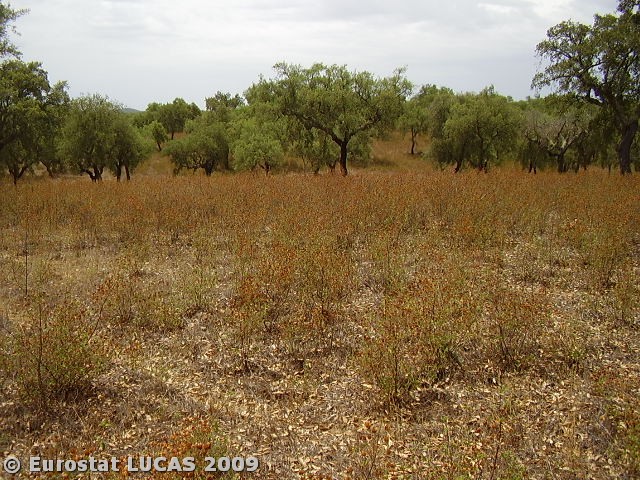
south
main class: Woodland
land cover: Broadleaved woodland
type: broadleaved evergreen forest
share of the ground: < 10 %
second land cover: Spontaneously vegetated surfaces
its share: 25 - 50 %
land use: Forestry
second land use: Fallow land
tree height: > 5 m
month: June
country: PT
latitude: 38.3998
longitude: -7.8167
